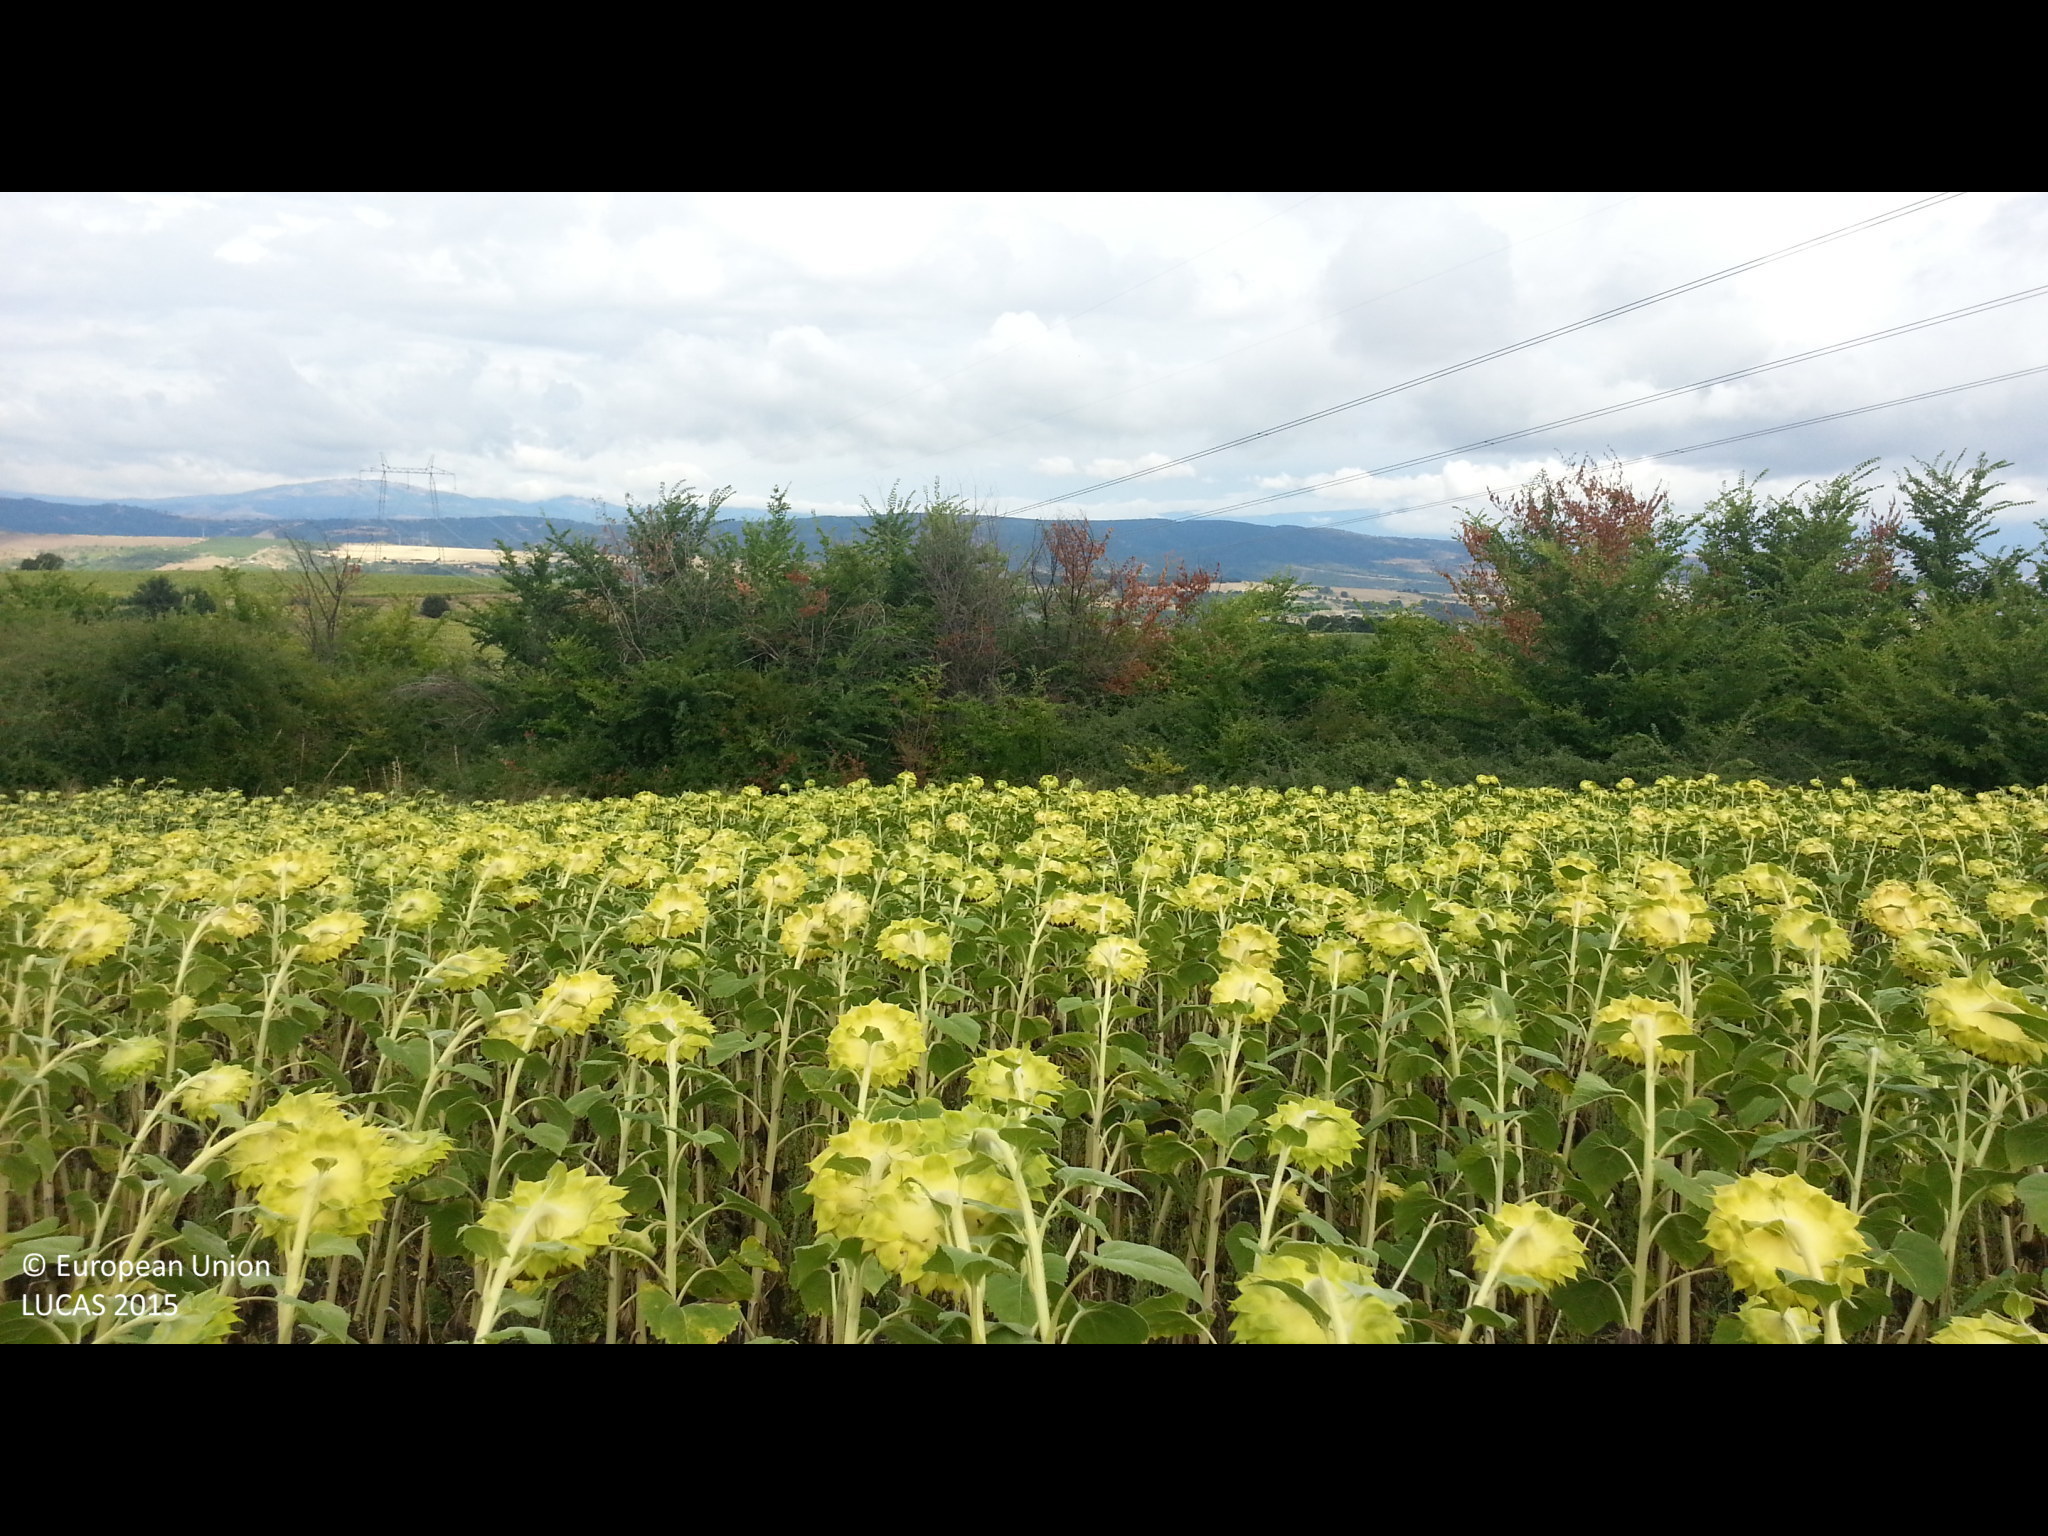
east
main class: Cropland
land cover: Sunflower
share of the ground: > 75 %
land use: Agriculture (excluding fallow land and kitchen gardens)
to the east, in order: Sunflower; Tracks; Broadleaved woodland; Tracks; Abandoned hedges; Tracks; Electric lines; Cherry fruit; Tracks; Cherry fruit
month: August
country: BG
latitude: 42.3094
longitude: 22.9701
